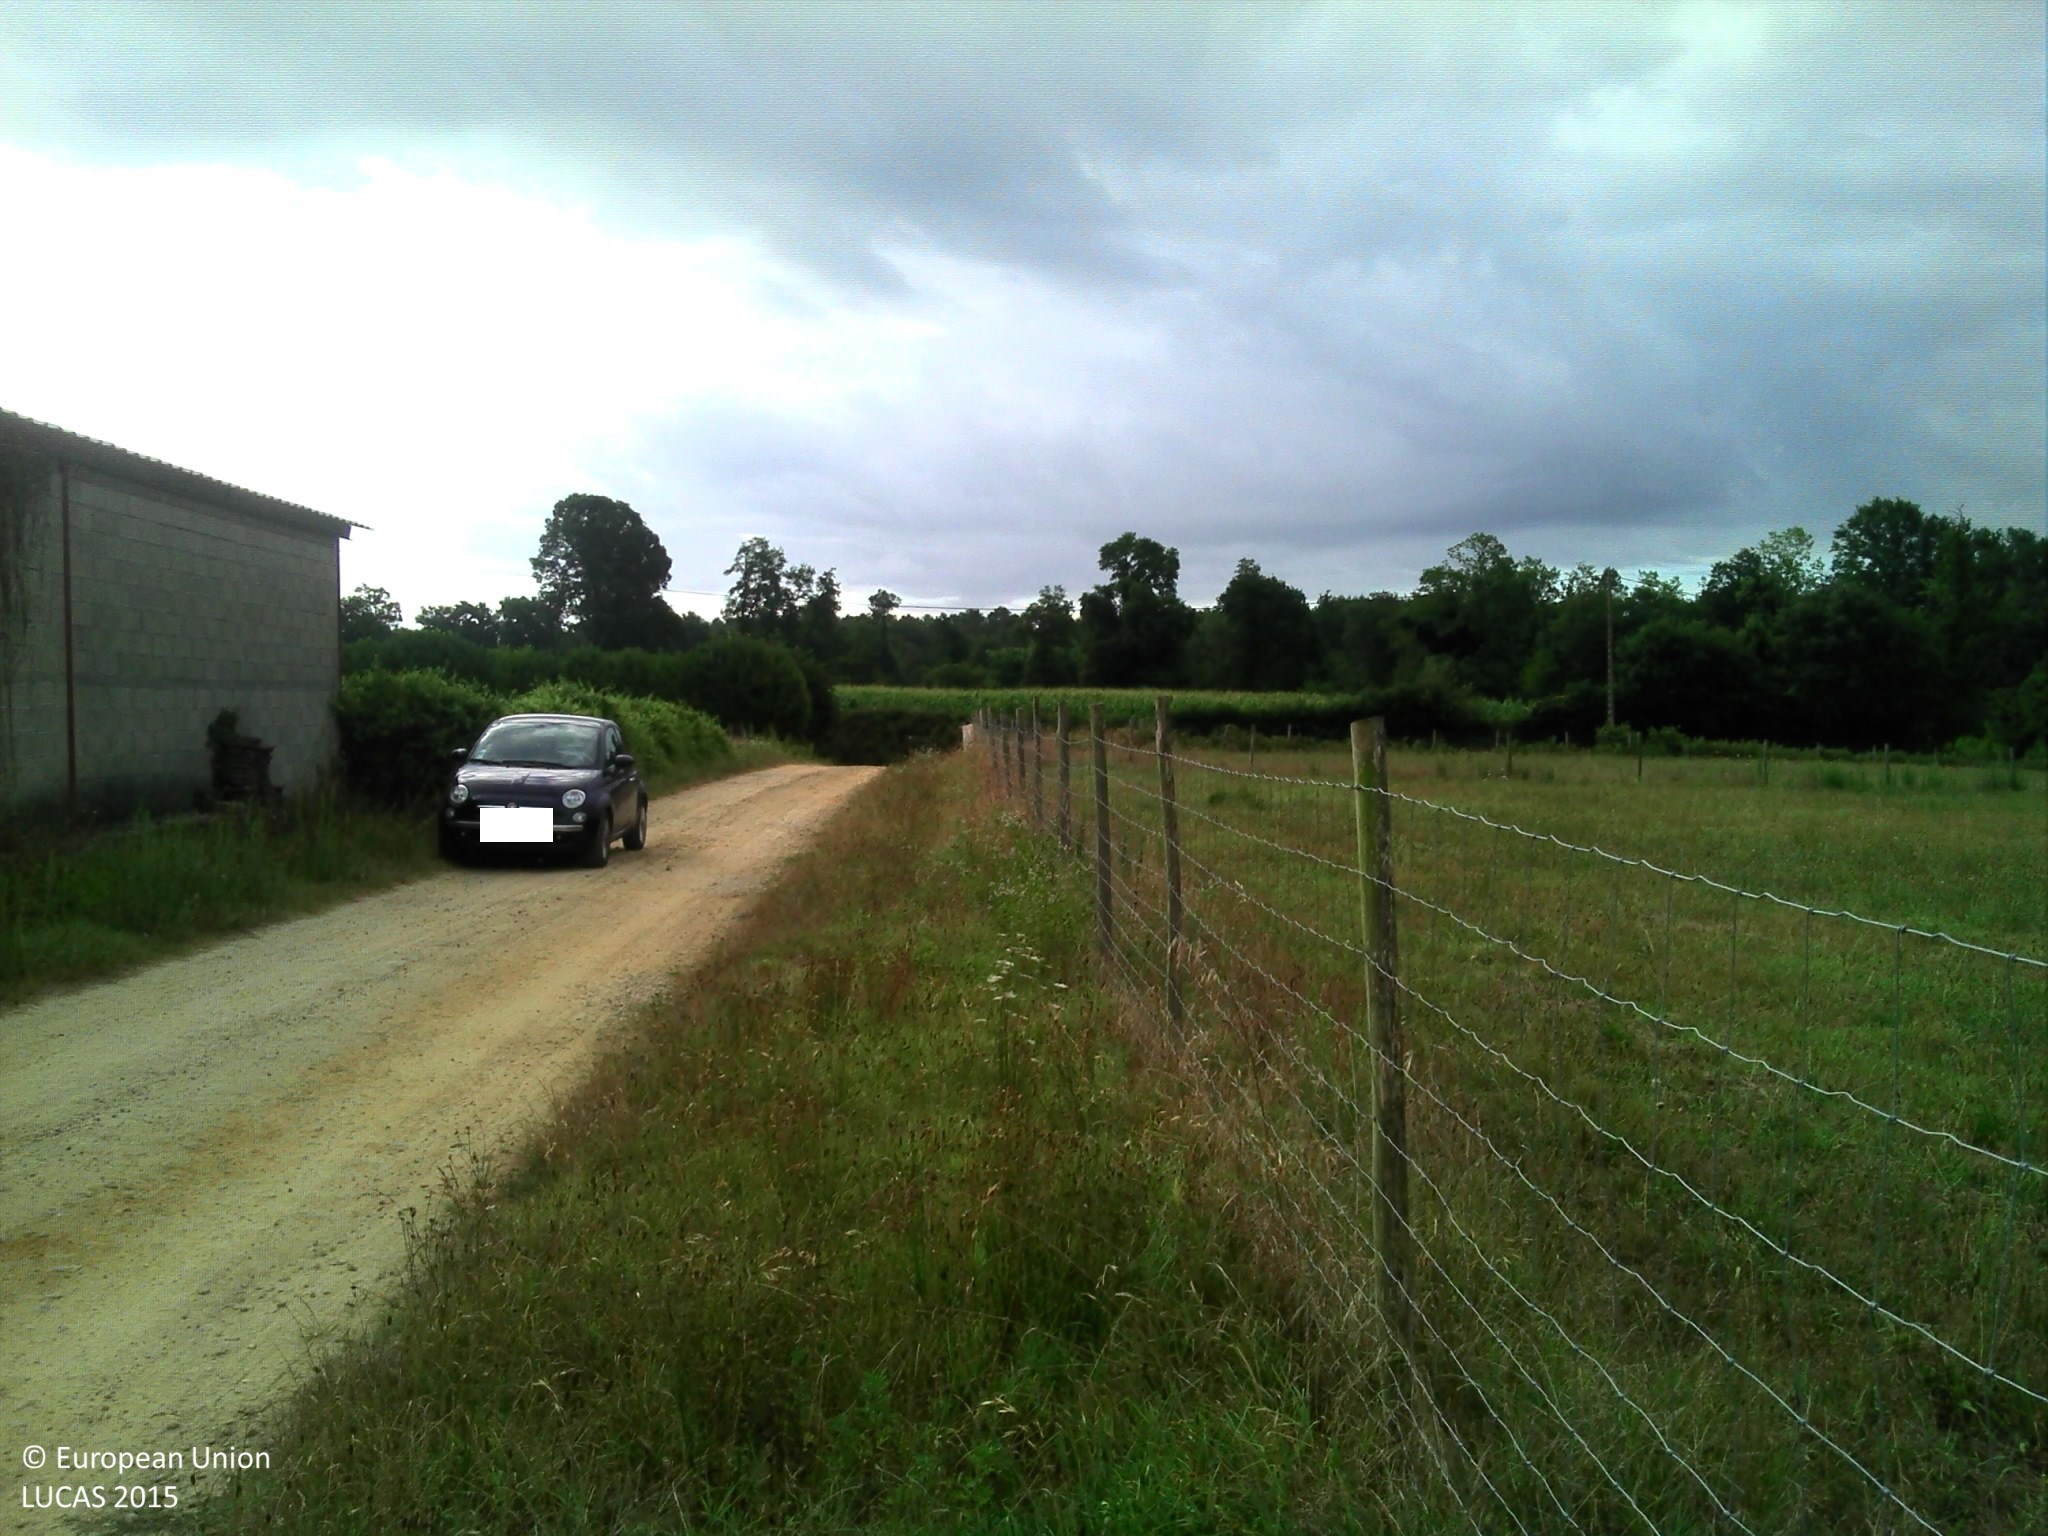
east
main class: Grassland
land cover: Grassland without tree/shrub cover
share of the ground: > 75 %
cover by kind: herbaceous plants 100 %
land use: Agriculture (excluding fallow land and kitchen gardens)
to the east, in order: Grassland without tree/shrub cover; Fences; Grassland without tree/shrub cover; Fences; Grass margins; Tracks; Grass margins; Managed hedges; Grassland without tree/shrub cover; Managed hedges; Electric lines; Ditches and canals; Grass margins; Paved roads, cycling and walking lanes; Grass margins; Ditches and canals; Shruby margins; Maize; Spontaneously vegetated surfaces; Other bare soil; Broadleaved woodland
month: July
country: FR
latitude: 43.8196
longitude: -0.8187
